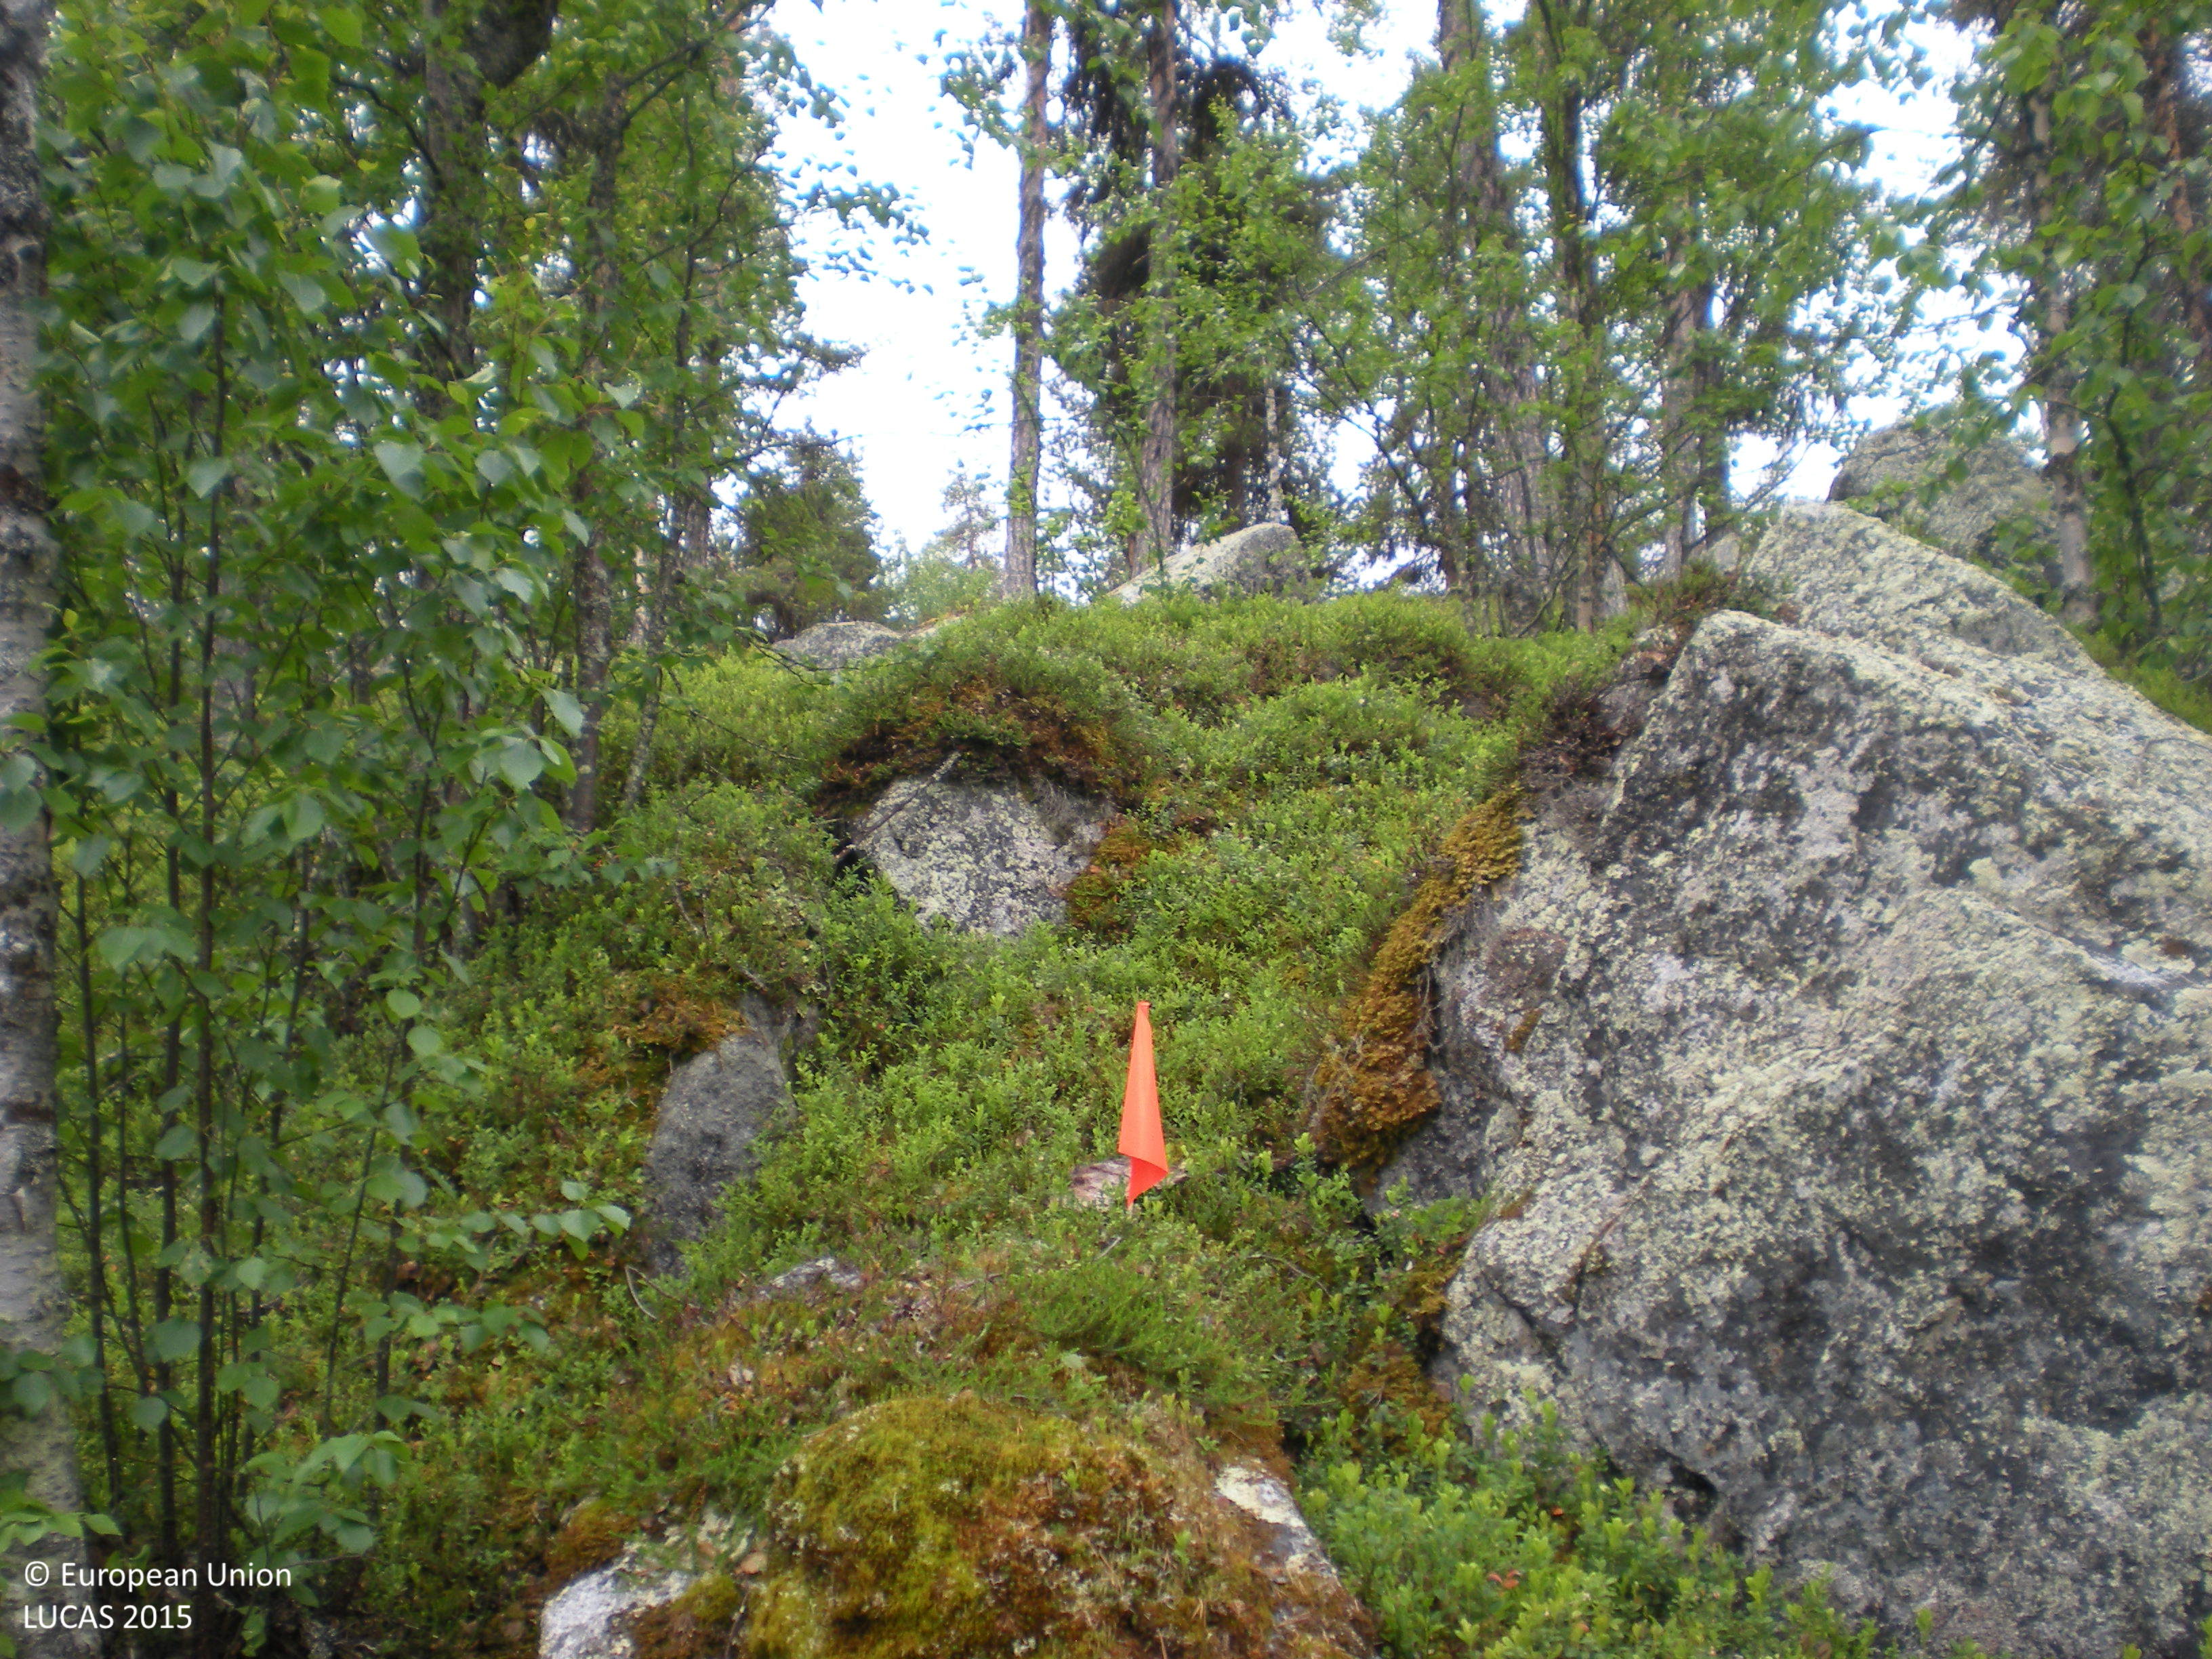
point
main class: Woodland
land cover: Pine dominated mixed woodland
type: boreal forest
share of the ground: 25 - 50 %
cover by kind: coniferous forest trees 30 %, shrubs 30 %, broadleaved forest trees 15 %, consolidated bare surface 15 %, lichens and mosses 10 %
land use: Forestry
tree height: > 5 m
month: July
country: SE
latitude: 65.5306
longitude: 17.0353
